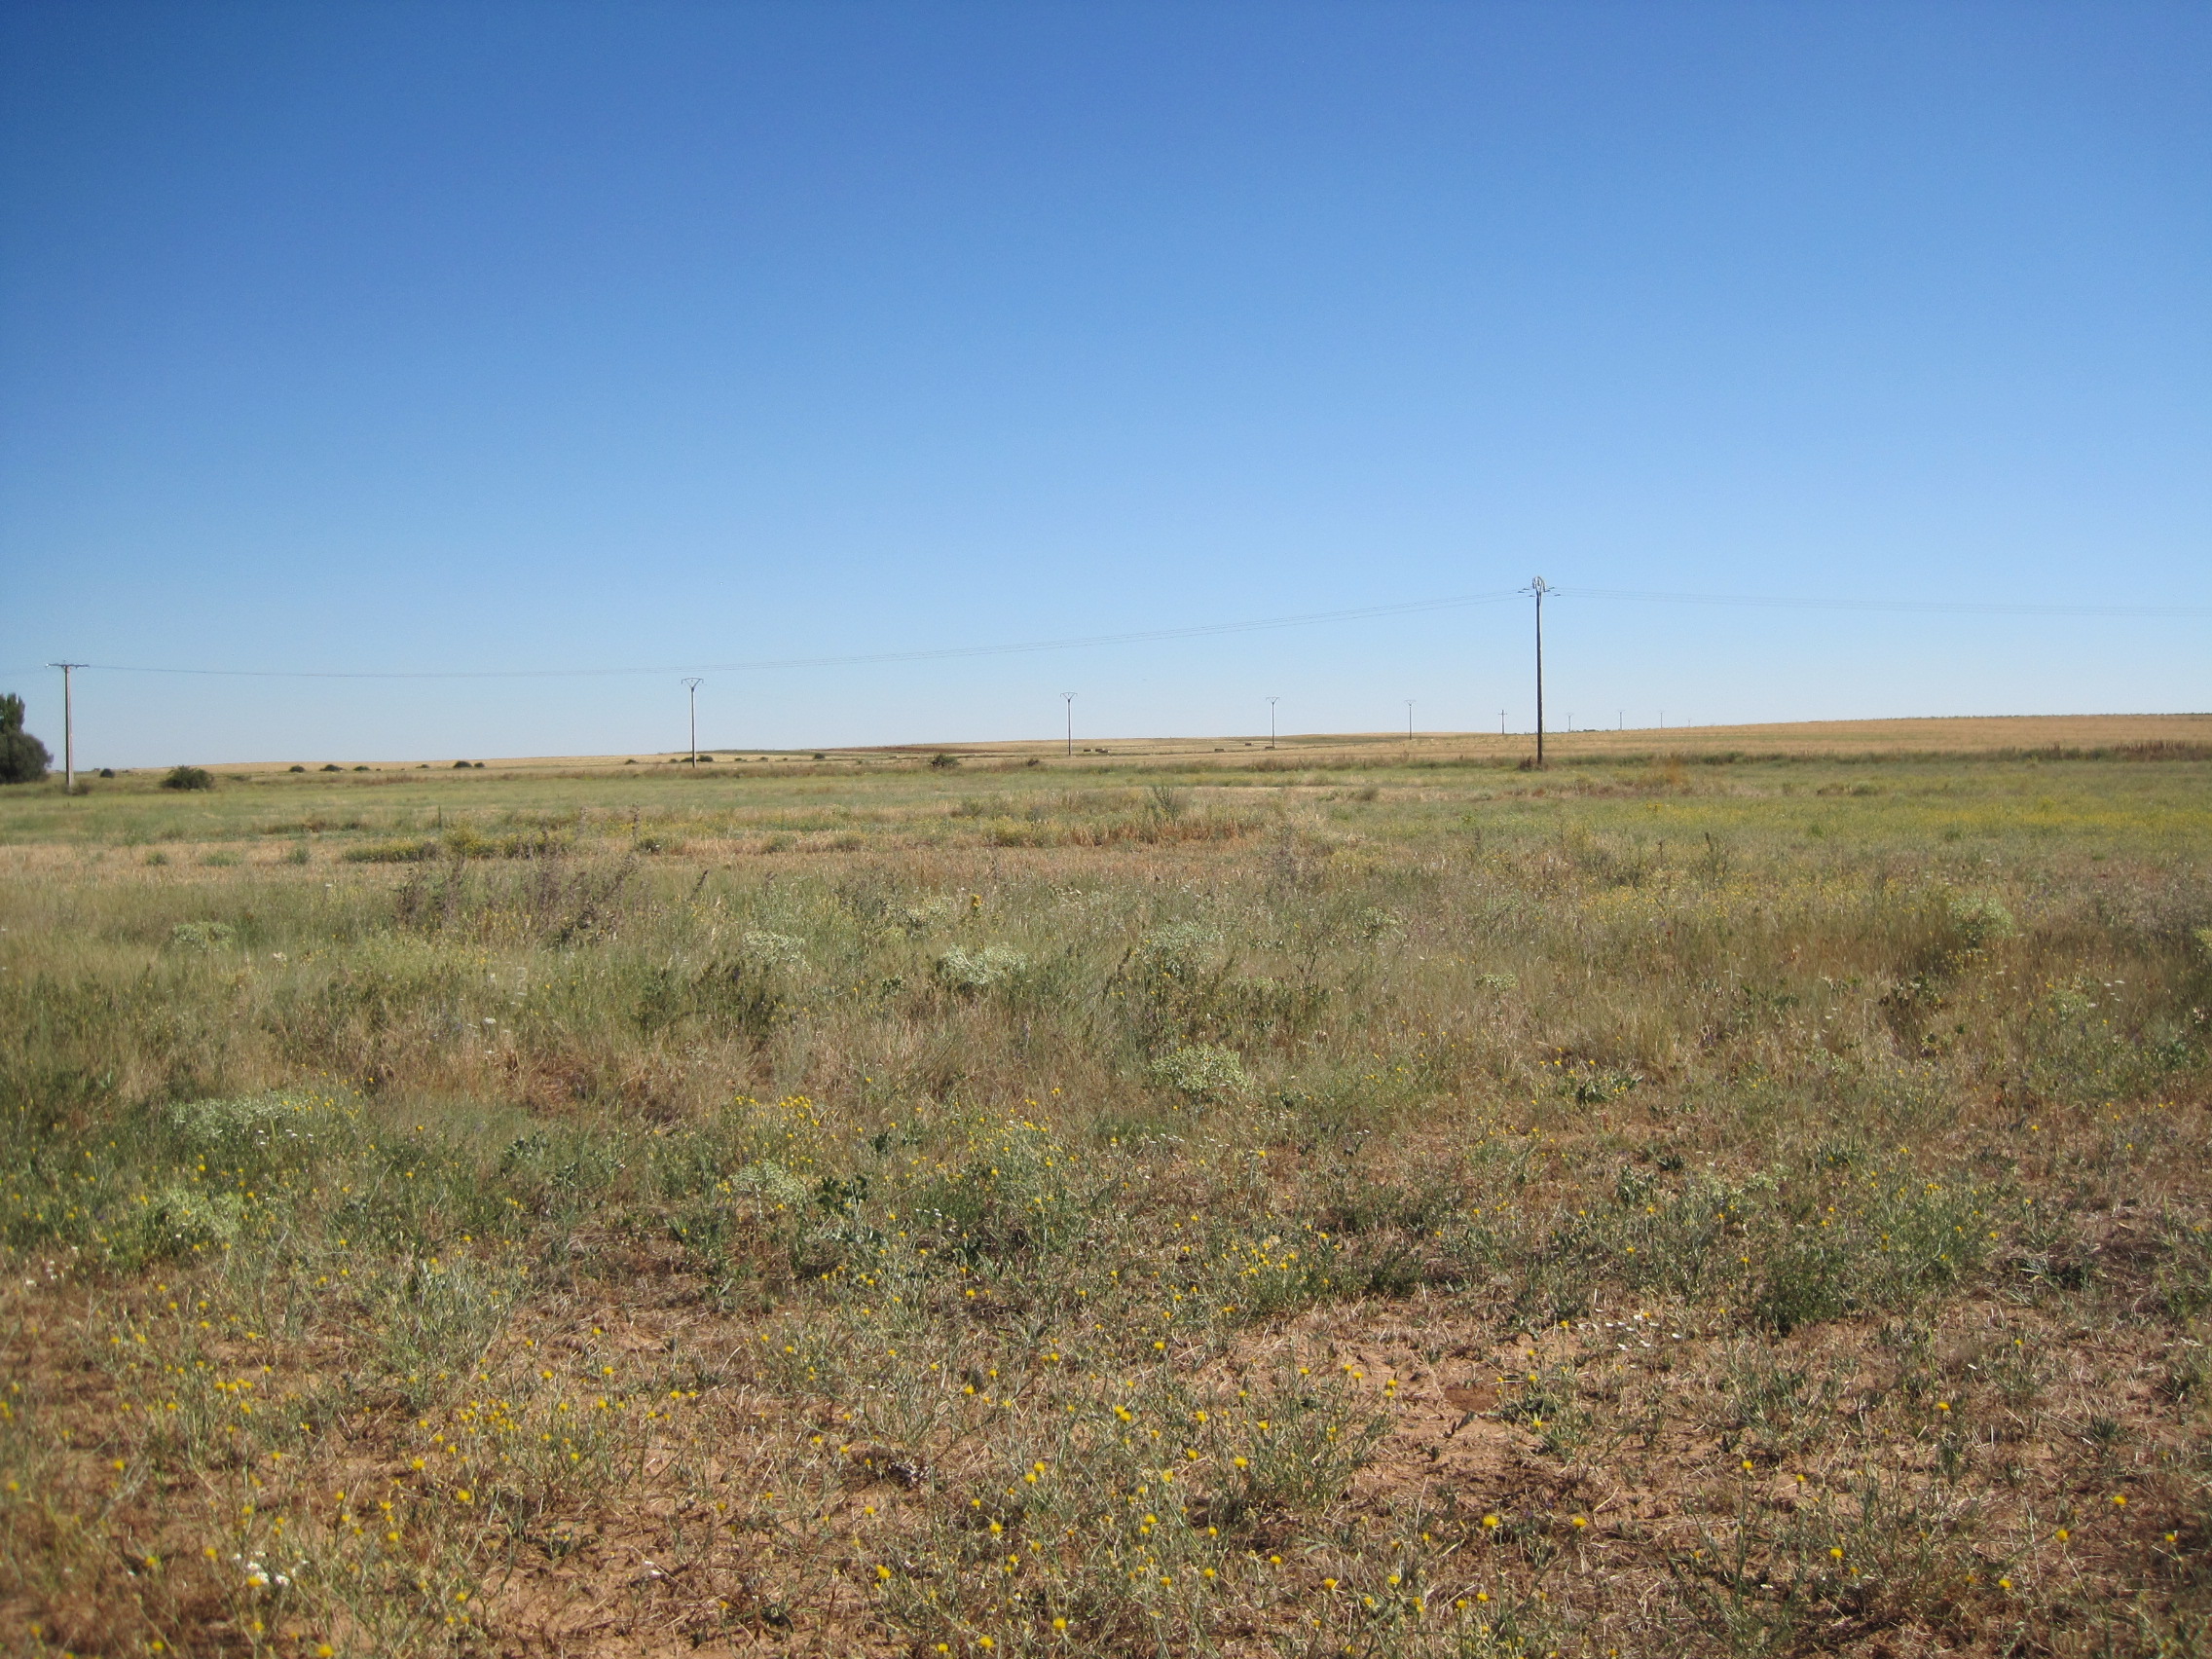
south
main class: Grassland
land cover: Grassland without tree/shrub cover
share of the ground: > 75 %
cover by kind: herbaceous plants 100 %
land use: Semi-natural and natural areas not in use
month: July
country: ES
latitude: 42.0706
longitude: -5.3016
